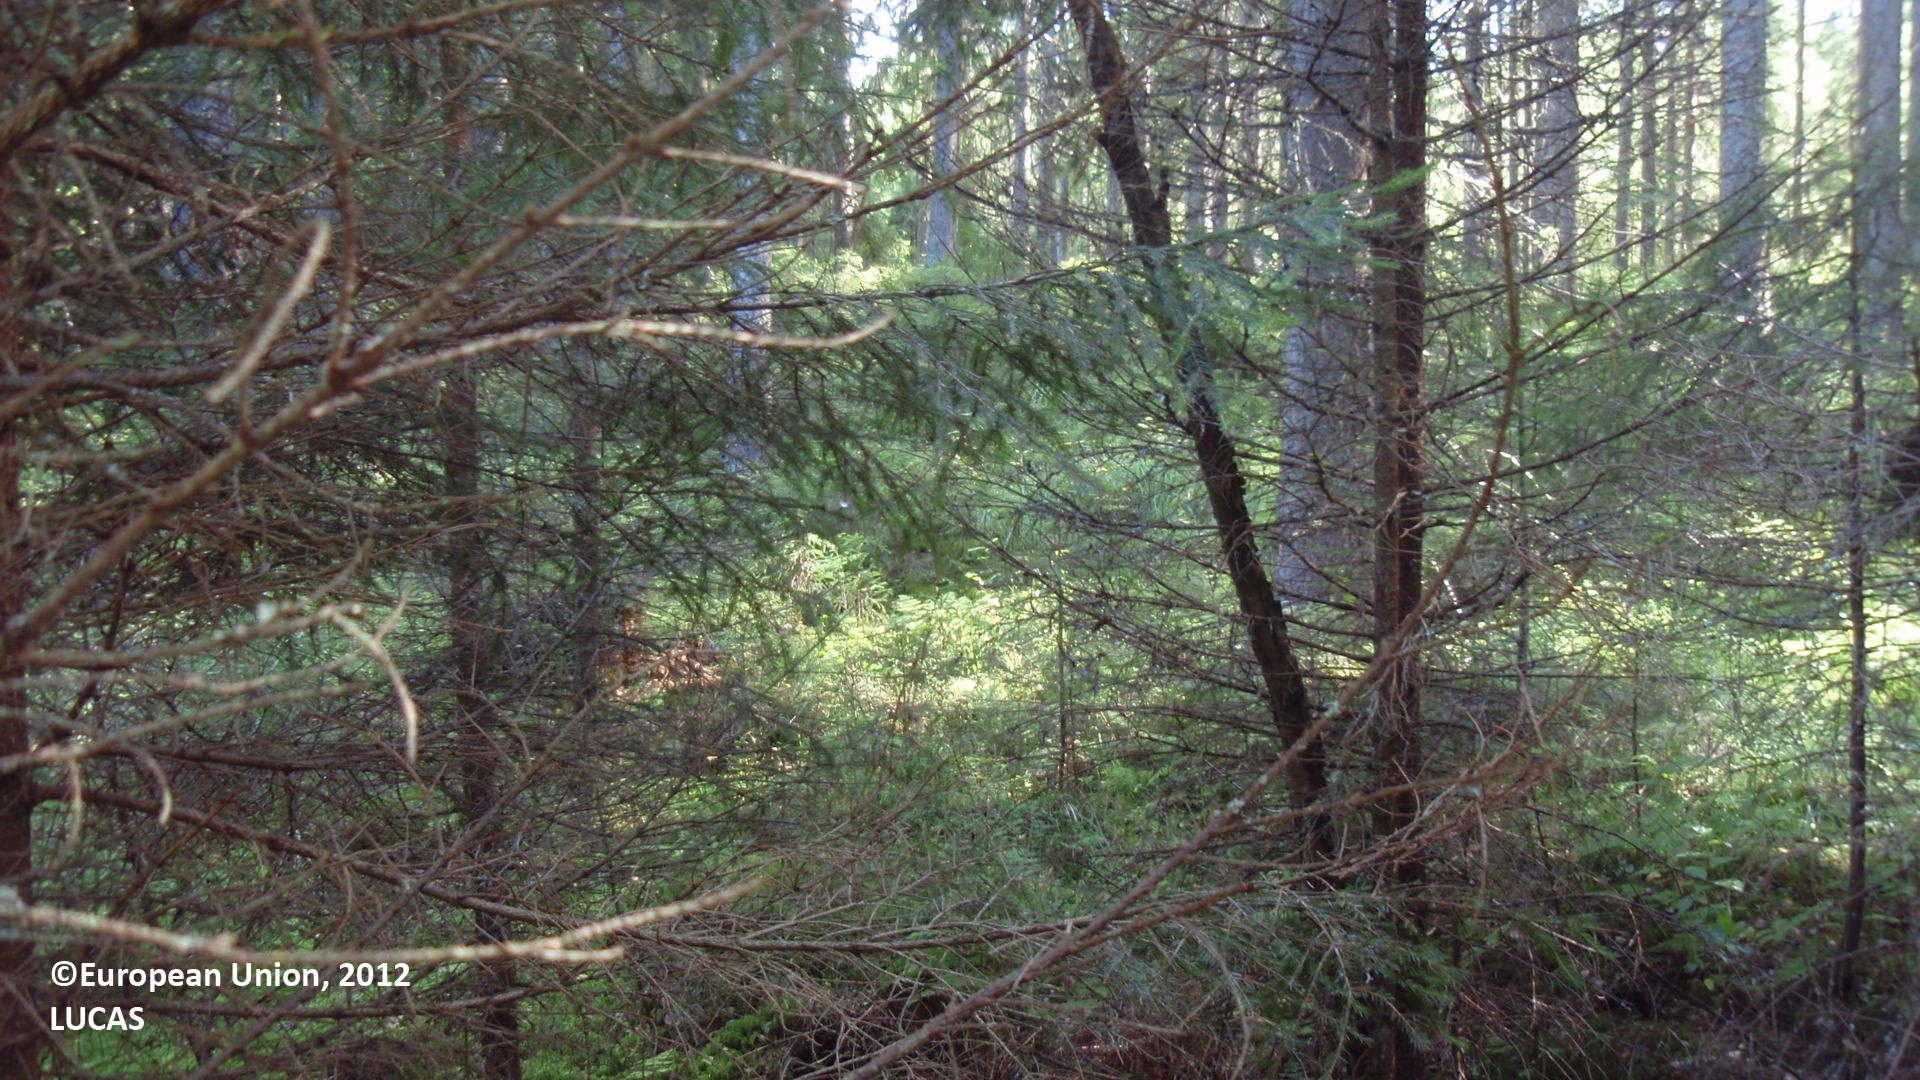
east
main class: Woodland
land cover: Spruce dominated coniferous woodland
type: boreal forest
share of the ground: > 75 %
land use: Forestry
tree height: > 5 m
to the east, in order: Spruce dominated coniferous woodland; Ditches and canals; Spruce dominated coniferous woodland; Spruce dominated mixed woodland; Spruce dominated coniferous woodland; Ditches and canals; Spruce dominated coniferous woodland; Spruce dominated mixed woodland
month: August
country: FI
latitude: 60.6204
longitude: 27.4145
